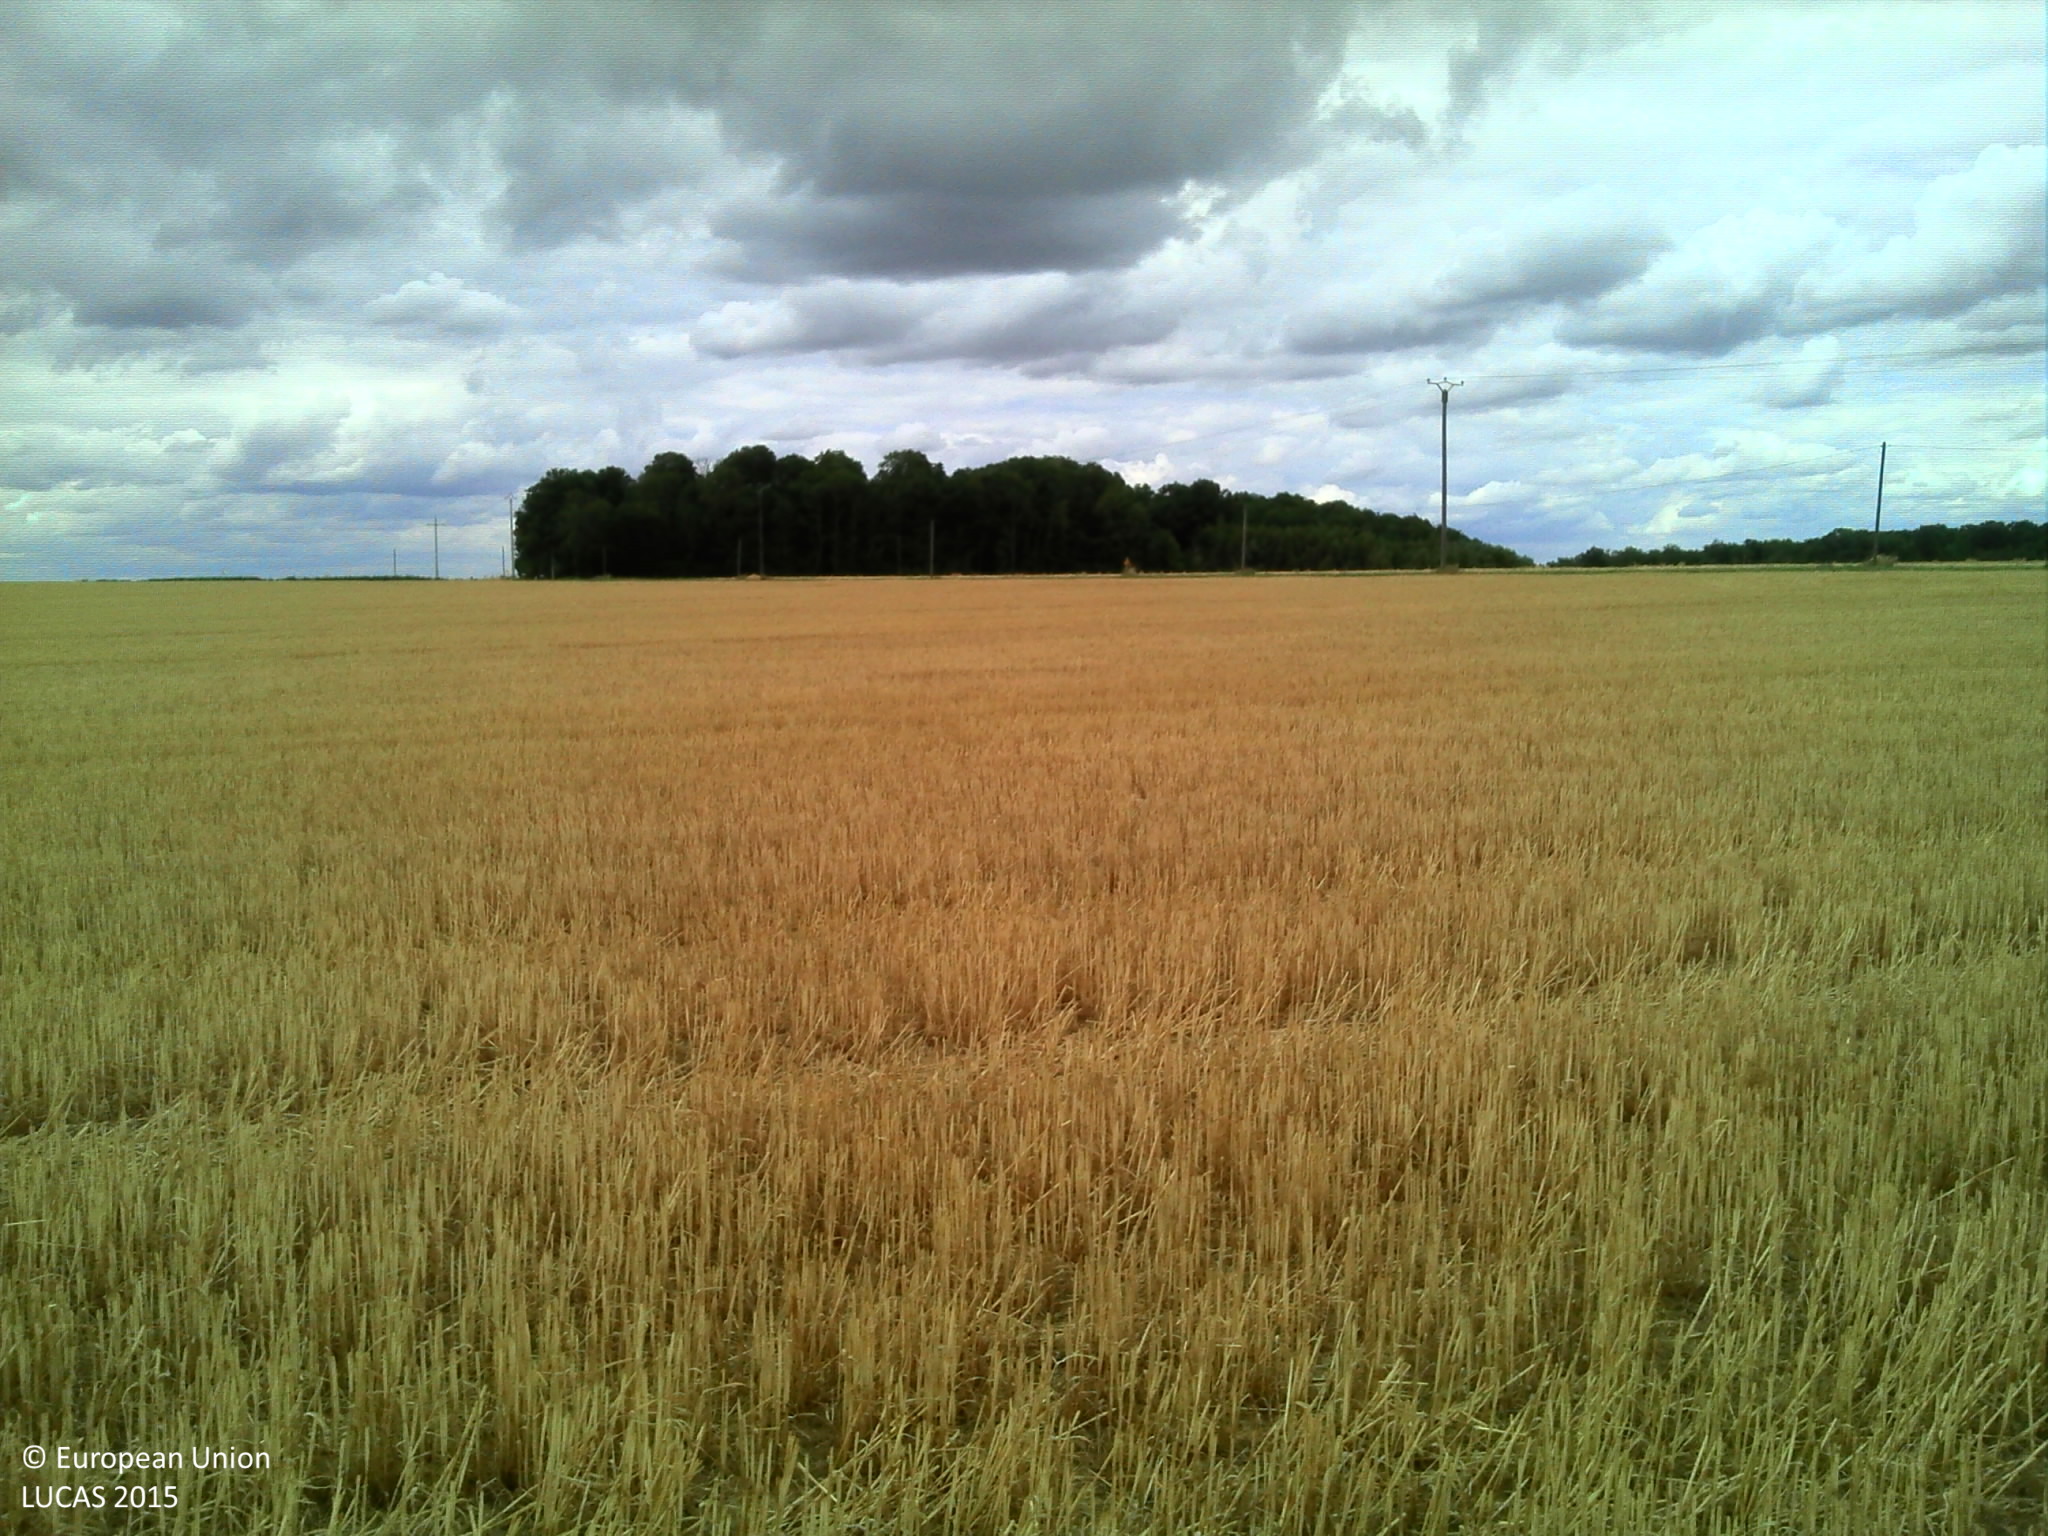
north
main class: Cropland
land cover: Common wheat
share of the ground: > 75 %
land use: Agriculture (excluding fallow land and kitchen gardens)
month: July
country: FR
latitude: 48.7671
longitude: 3.4219
